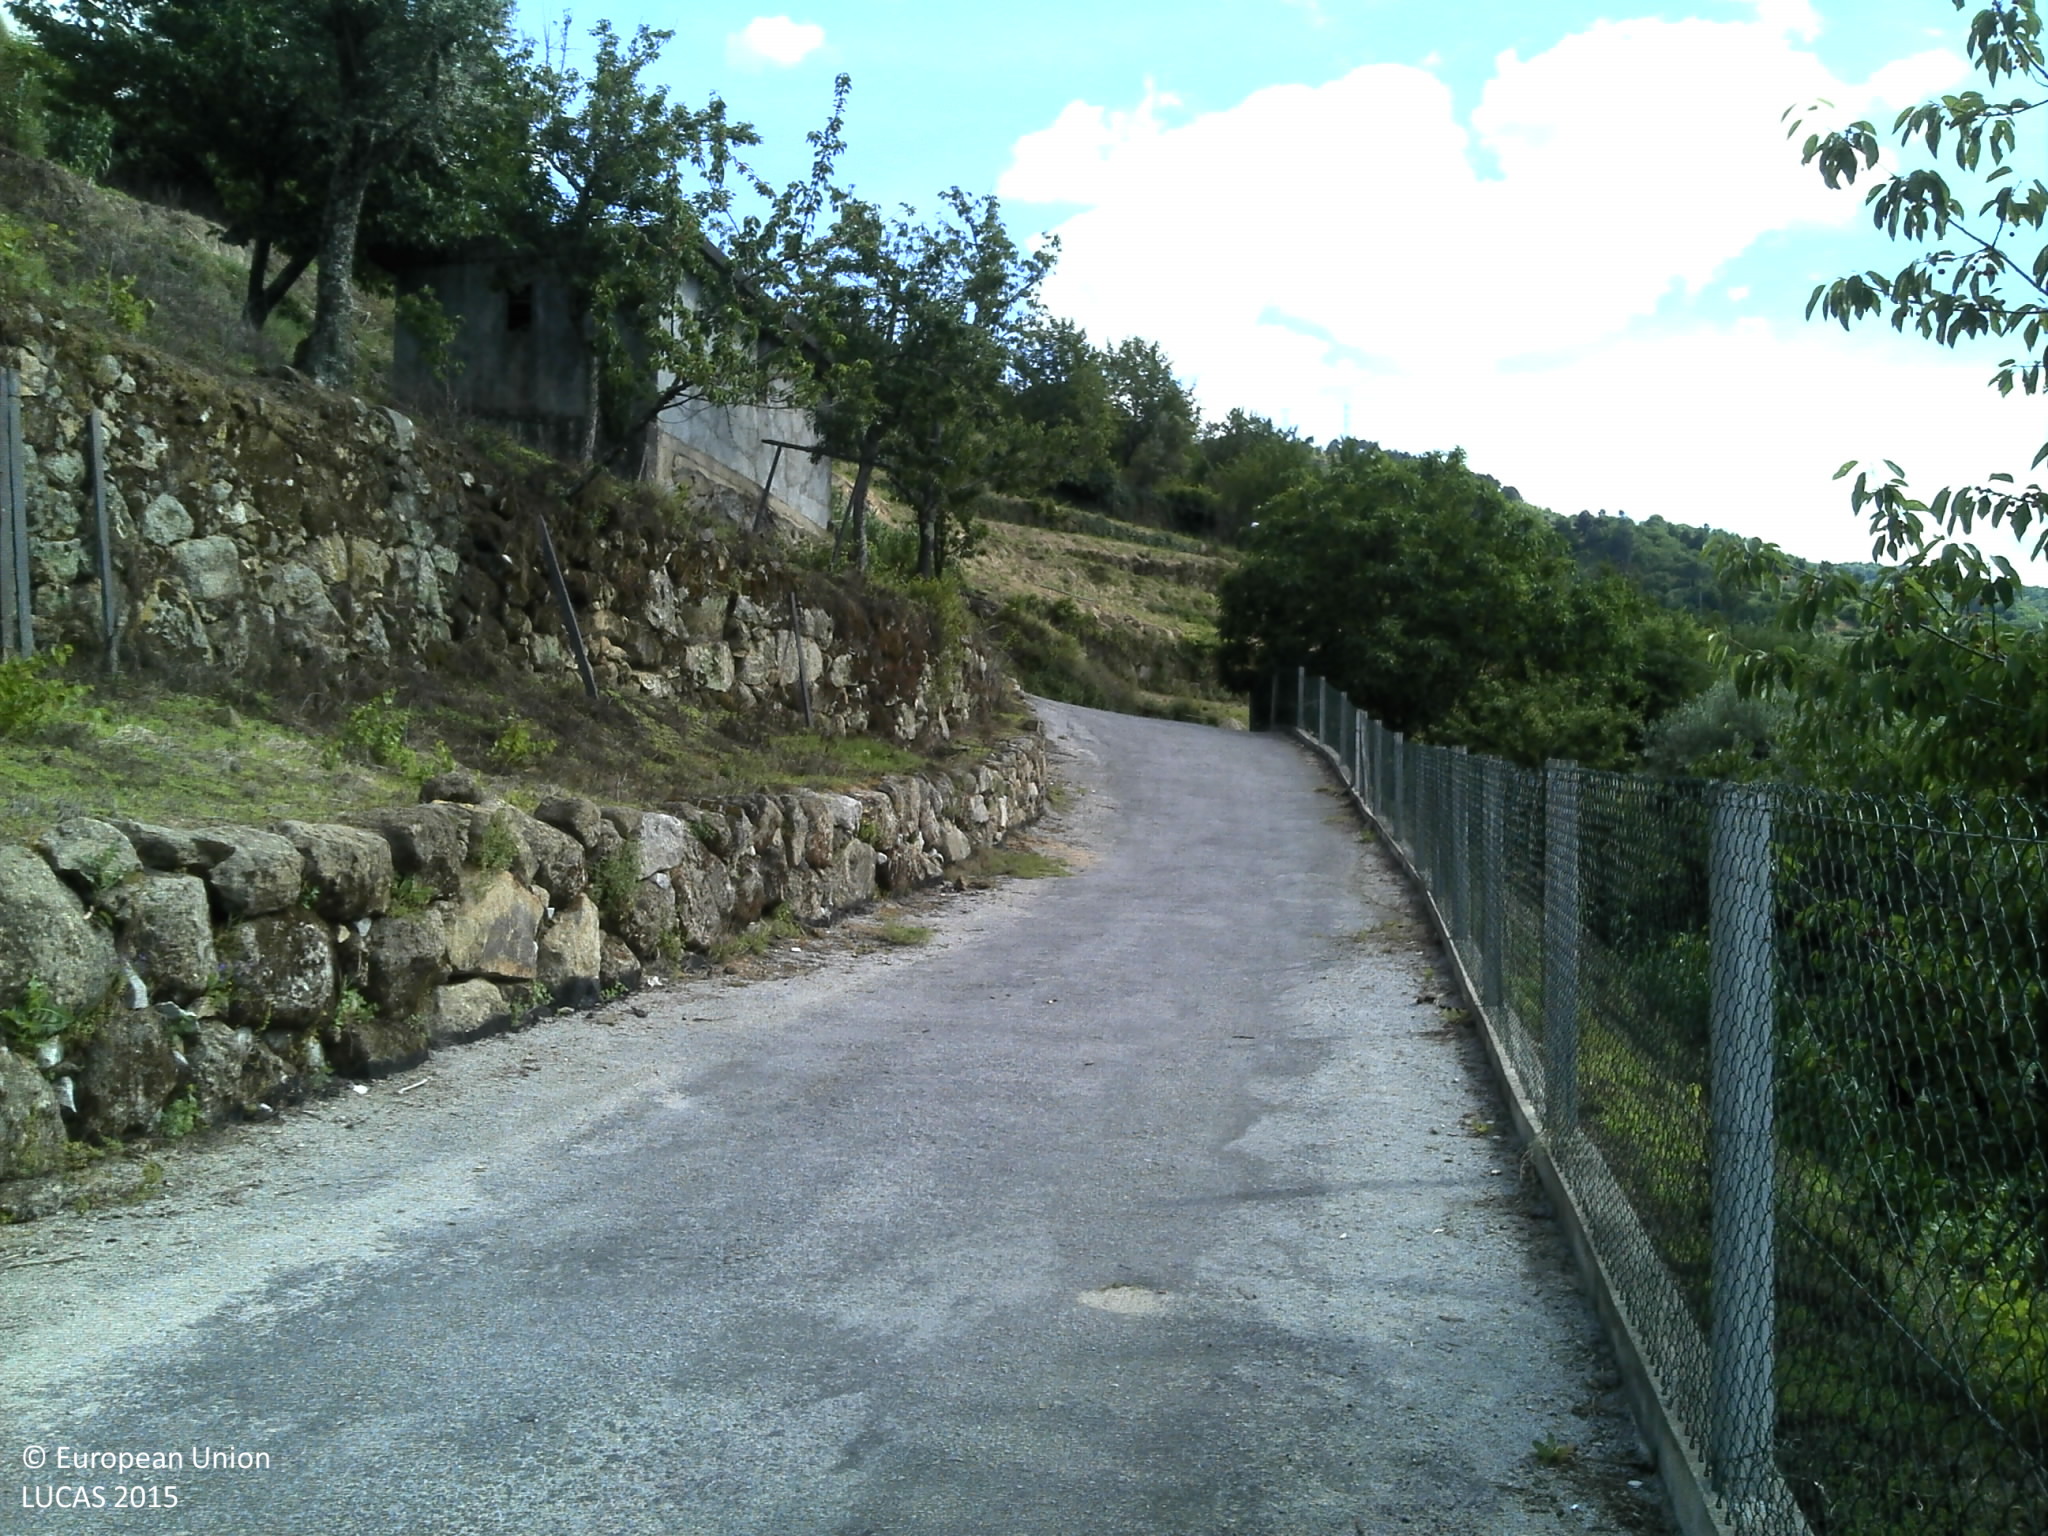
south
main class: Cropland
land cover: Cherry fruit
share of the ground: > 75 %
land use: Agriculture (excluding fallow land and kitchen gardens)
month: May
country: PT
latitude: 41.1155
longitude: -7.9127
